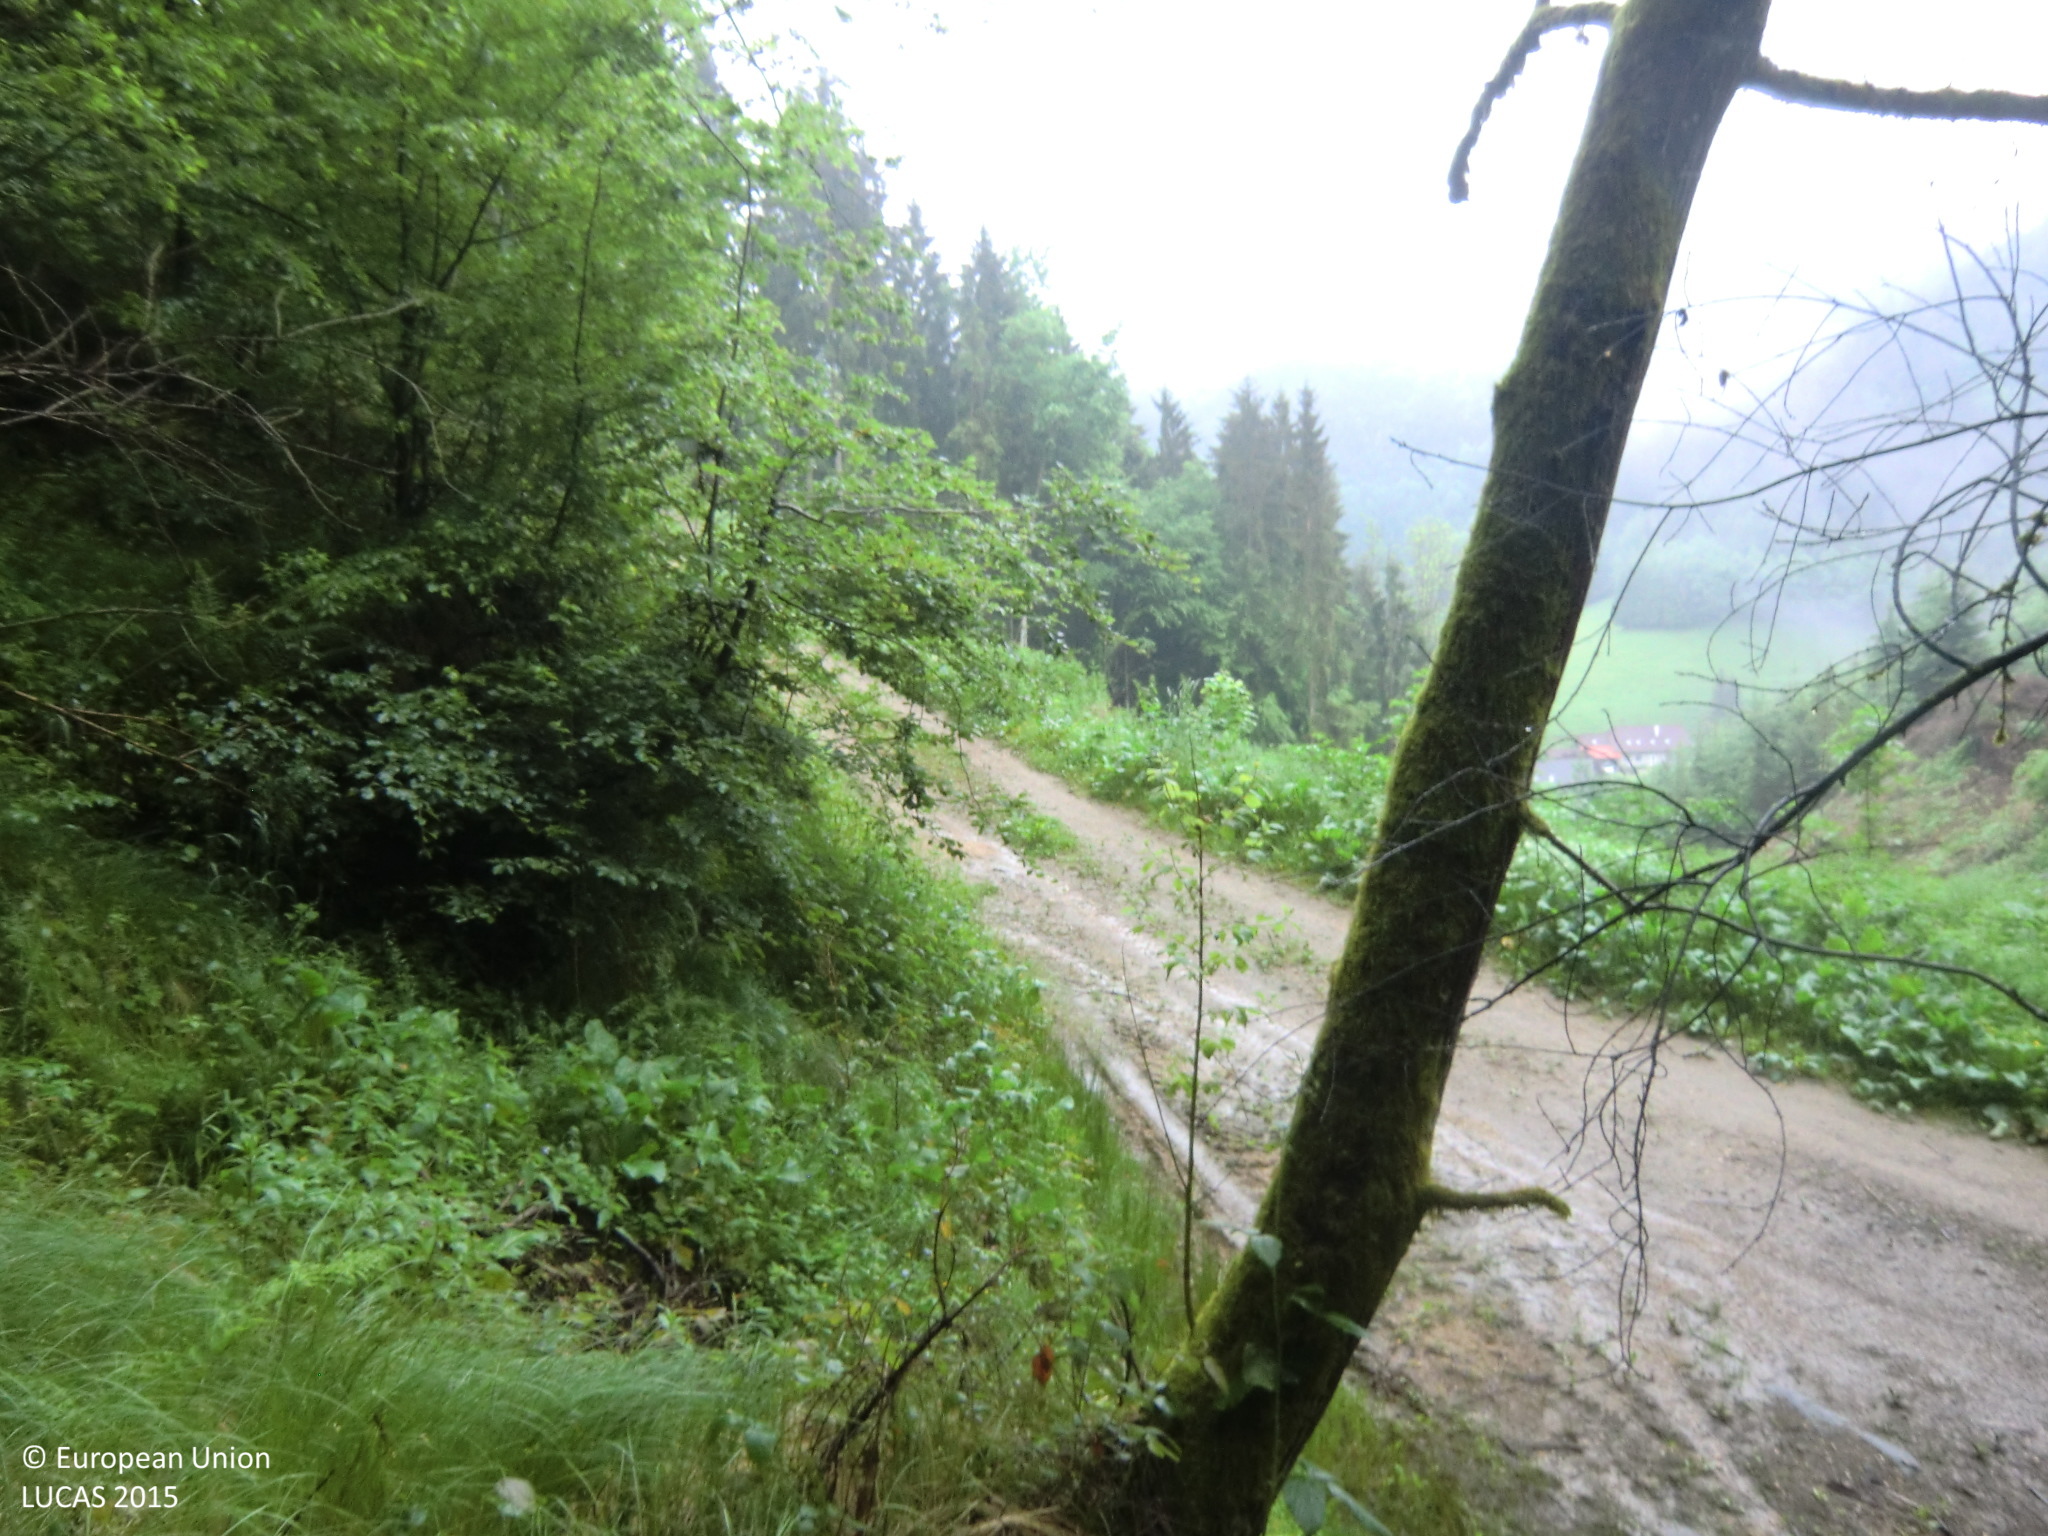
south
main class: Woodland
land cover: Spruce dominated mixed woodland
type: hemiboreal forest and nemoral coniferous forest and mixed broadleaved-coniferous forest
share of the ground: > 75 %
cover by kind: coniferous forest trees 40 %, broadleaved forest trees 40 %, herbaceous plants 20 %
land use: Forestry
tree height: > 5 m
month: May
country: AT
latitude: 48.3629
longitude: 14.5762
